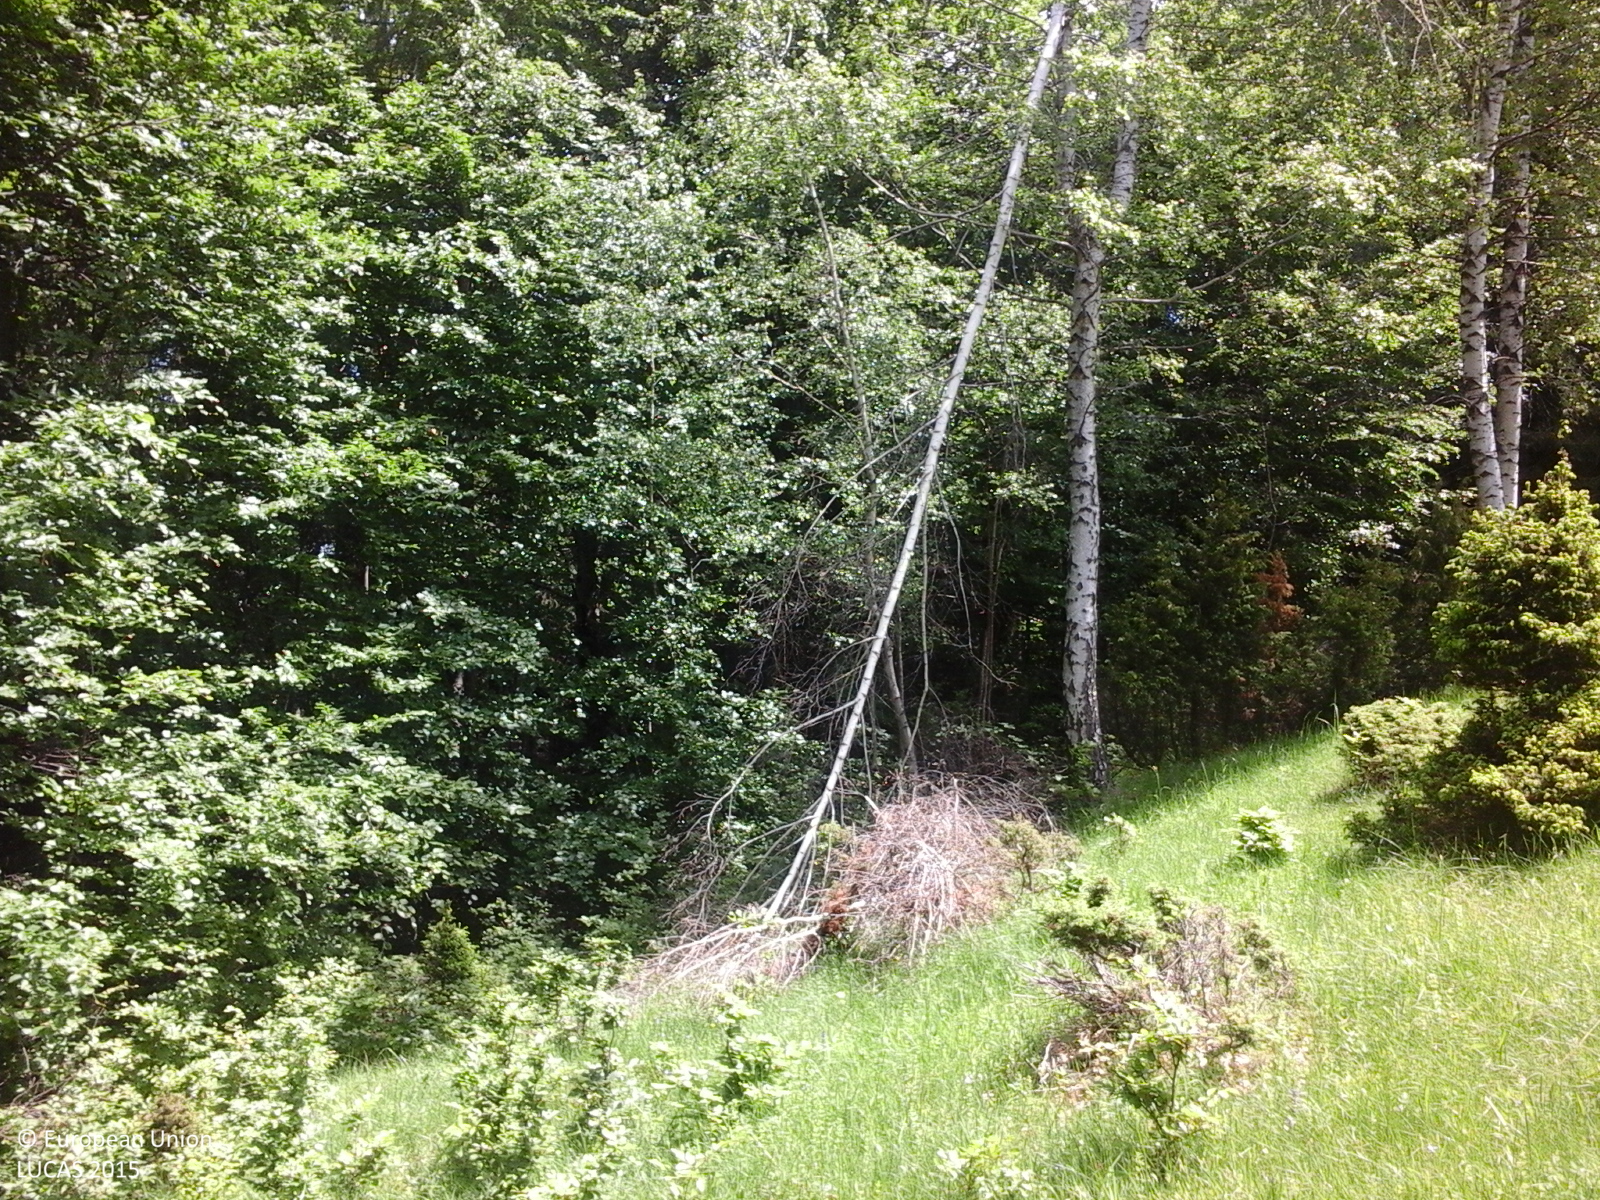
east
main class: Grassland
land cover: Grassland with sparse tree/shrub cover
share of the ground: > 75 %
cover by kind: herbaceous plants 90 %, broadleaved forest trees 5 %, shrubs 5 %
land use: Forestry
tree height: > 5 m
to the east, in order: Grassland with sparse tree/shrub cover; Broadleaved woodland
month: May
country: RO
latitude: 45.3974
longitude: 26.0951
